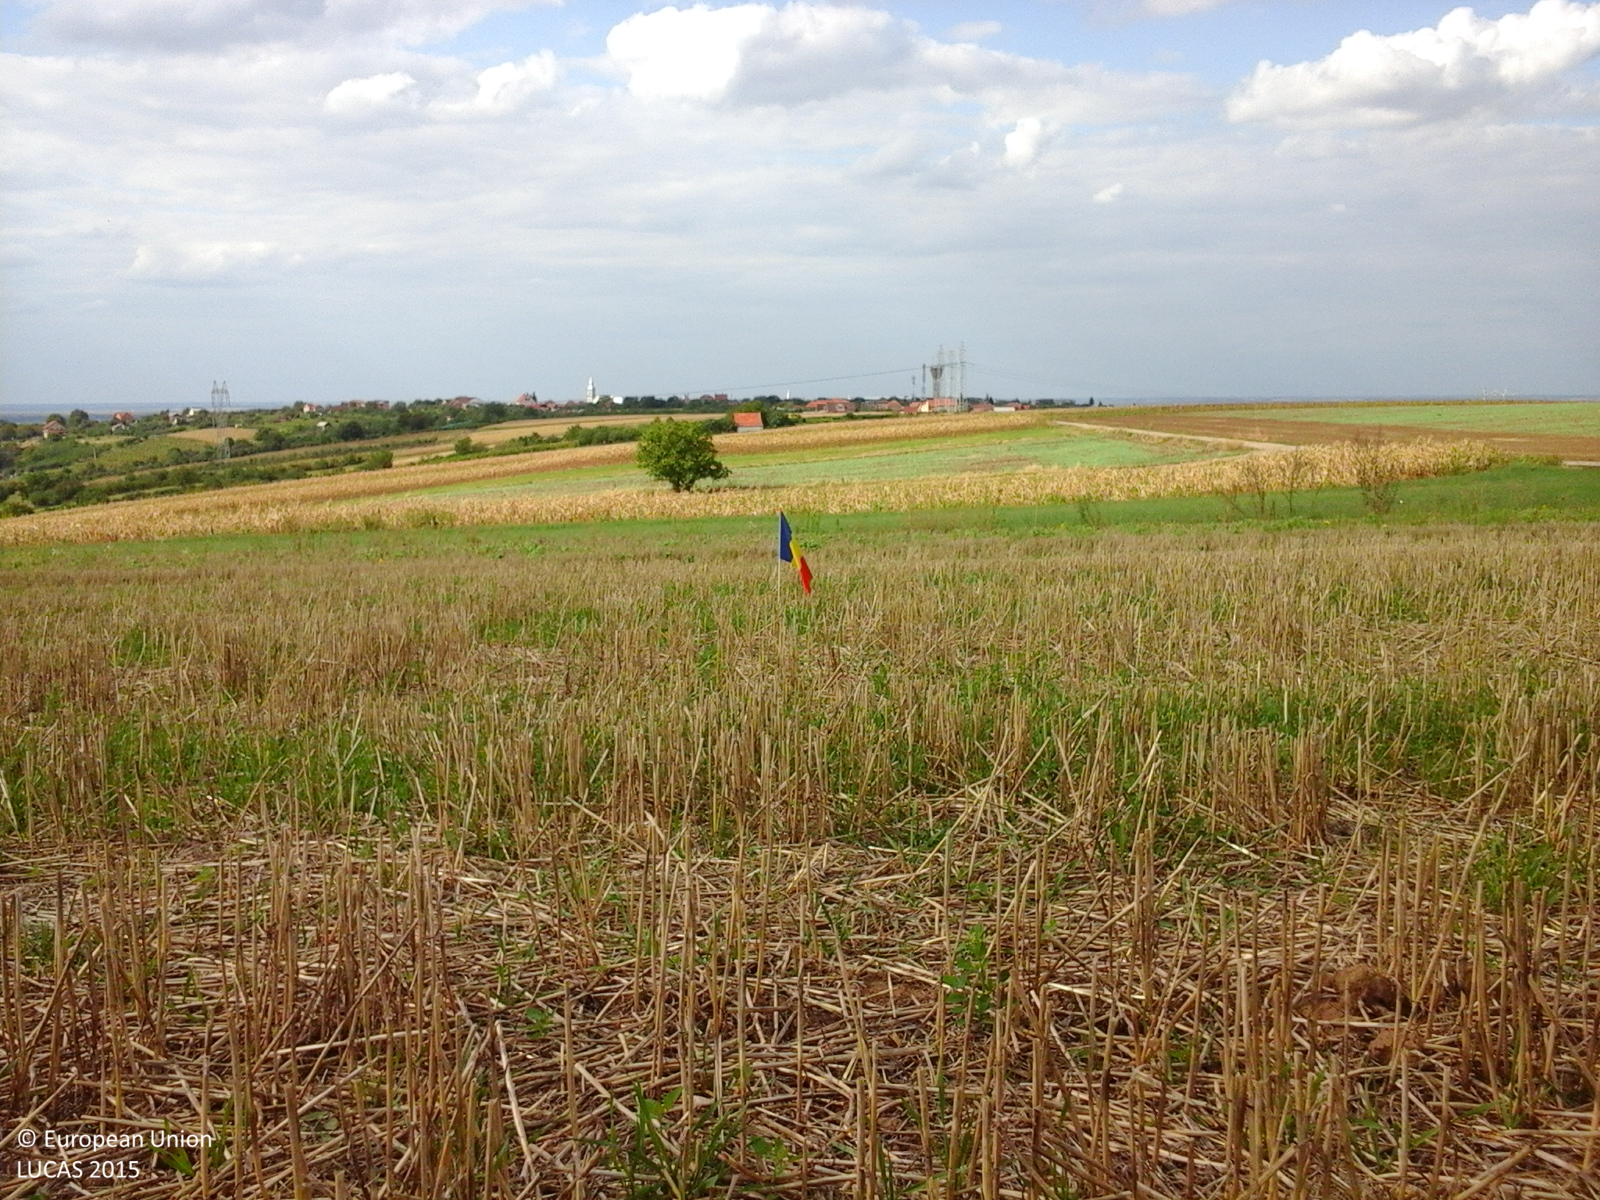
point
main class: Cropland
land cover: Common wheat
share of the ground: 50 - 75 %
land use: Agriculture (excluding fallow land and kitchen gardens)
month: September
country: RO
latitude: 47.4614
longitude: 22.5942
